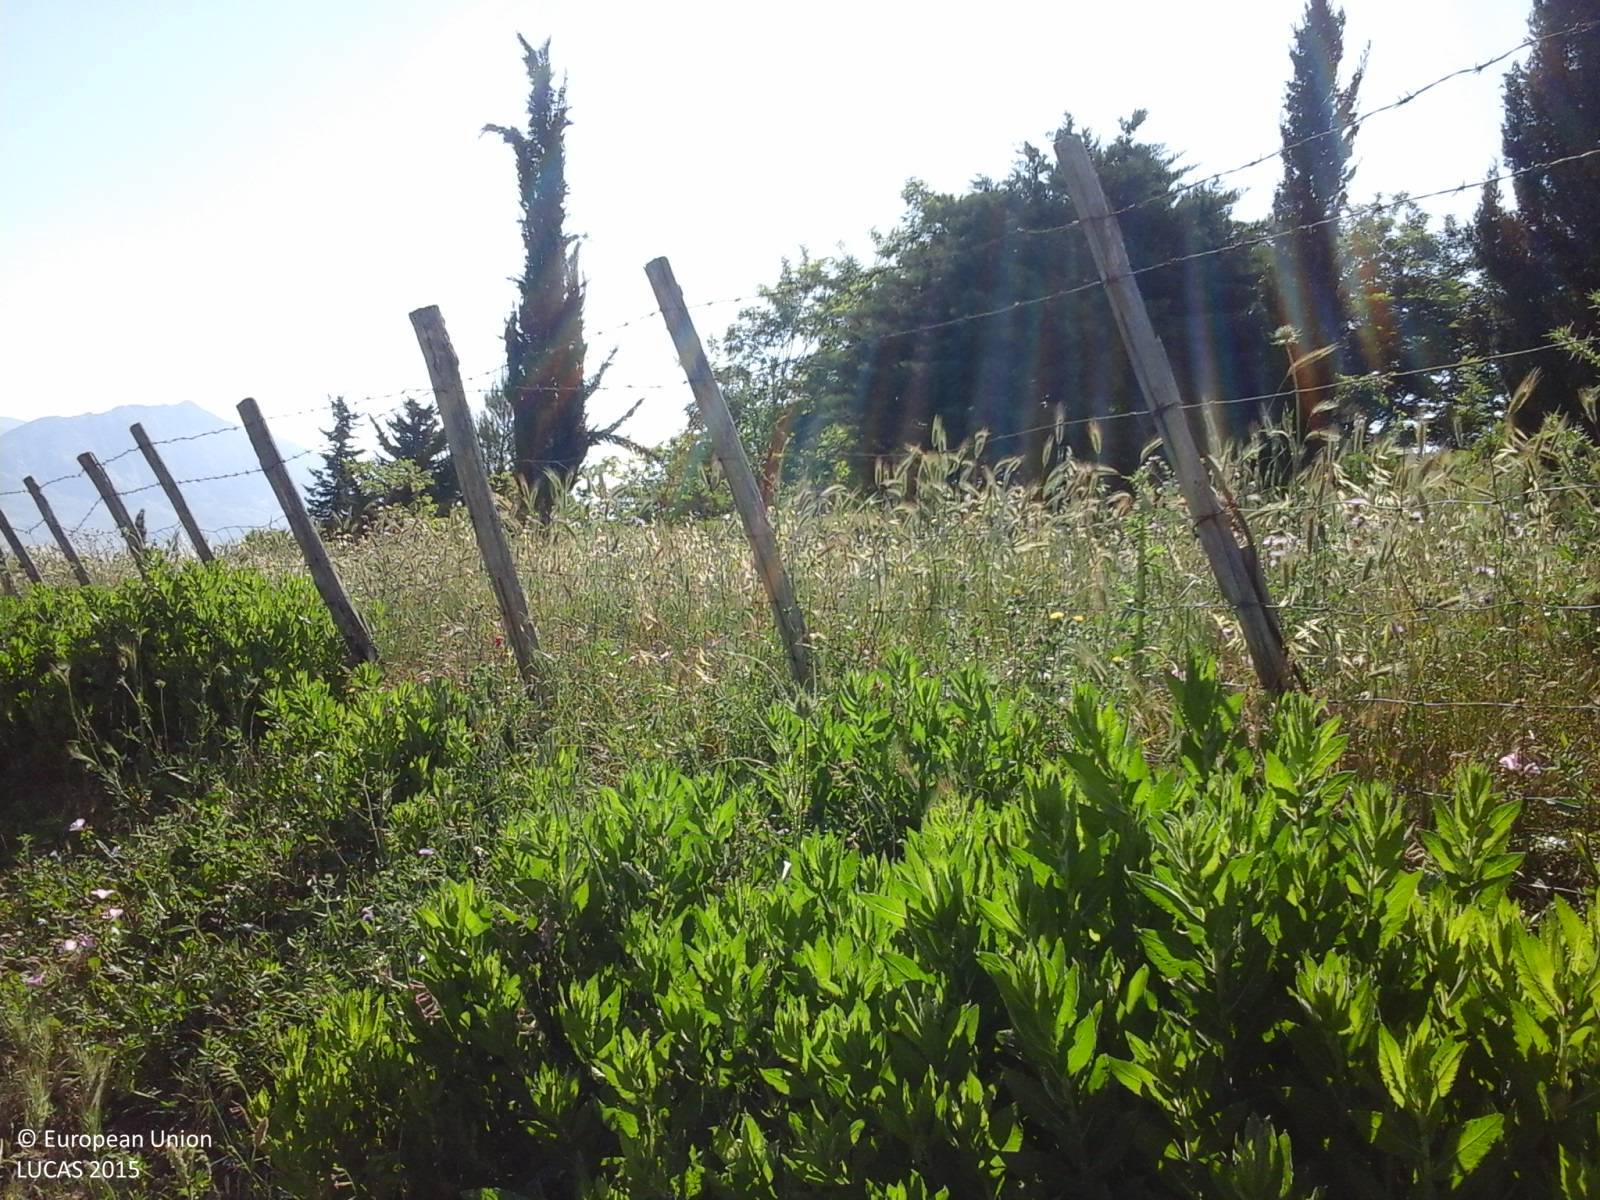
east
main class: Grassland
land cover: Grassland without tree/shrub cover
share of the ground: > 75 %
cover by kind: herbaceous plants 100 %
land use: Semi-natural and natural areas not in use
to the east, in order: Grassland without tree/shrub cover; Other mixed woodland; Grassland without tree/shrub cover; Fences; Paved roads, cycling and walking lanes; Grass margins; Tracks; Electric lines; Tracks; Grass margins; Spontaneously vegetated surfaces
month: June
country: IT
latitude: 37.9699
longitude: 13.0854
